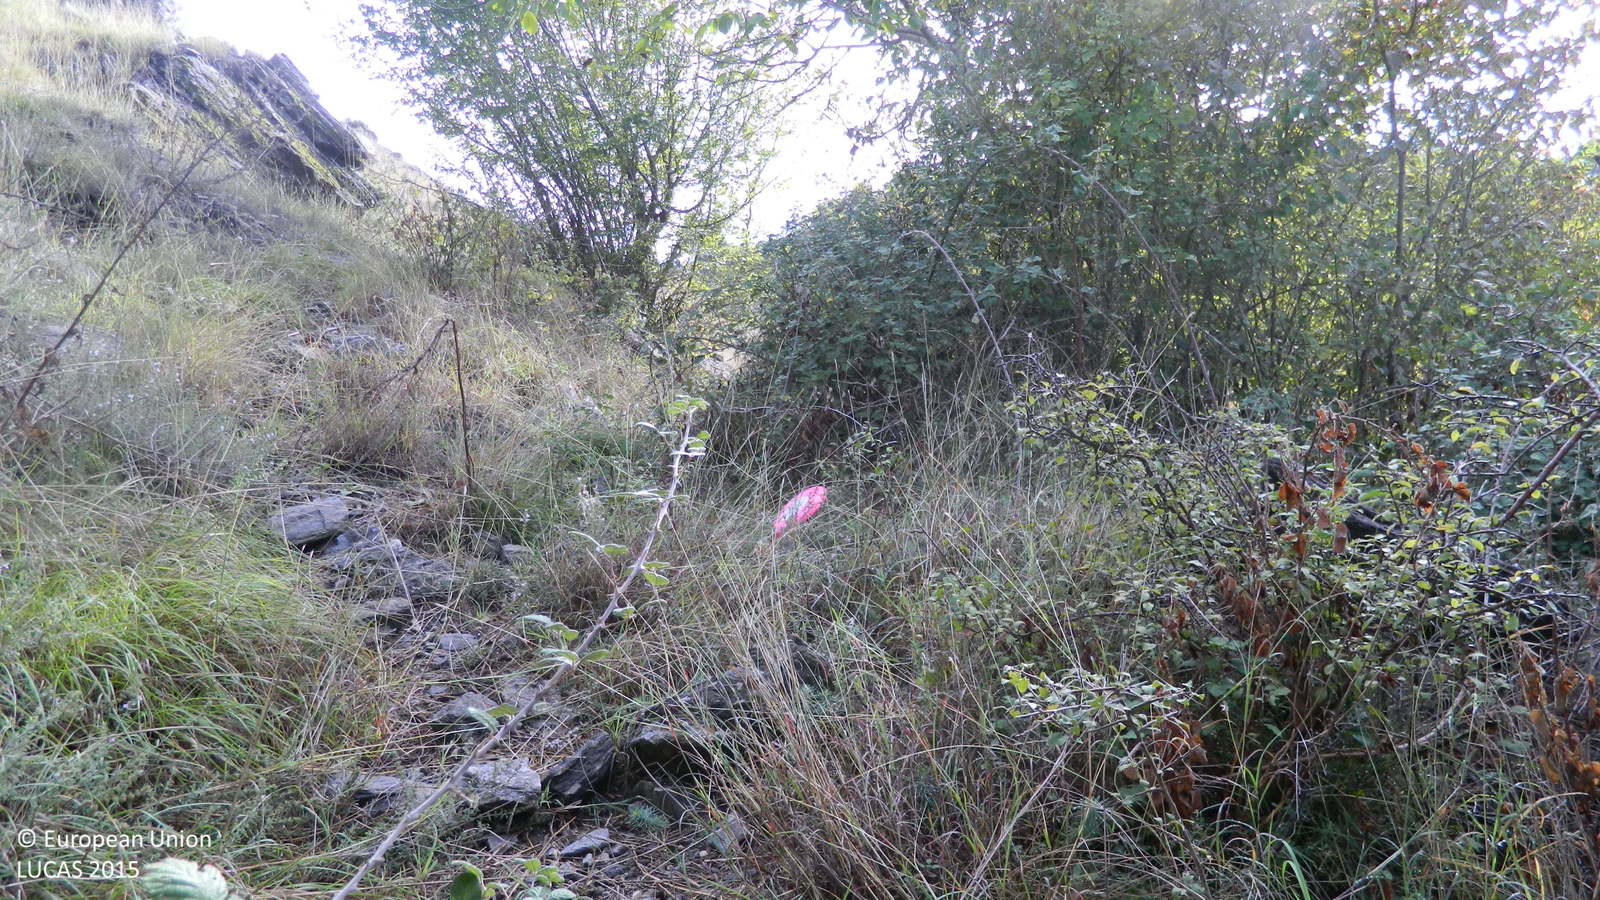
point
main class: Shrubland
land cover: Shrubland with sparse tree cover
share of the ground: > 75 %
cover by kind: shrubs 70 %, unconsolidated bare surface 15 %, herbaceous plants 10 %, broadleaved forest trees 5 %
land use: Abandoned areas
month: September
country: BG
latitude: 41.4741
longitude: 24.0057
